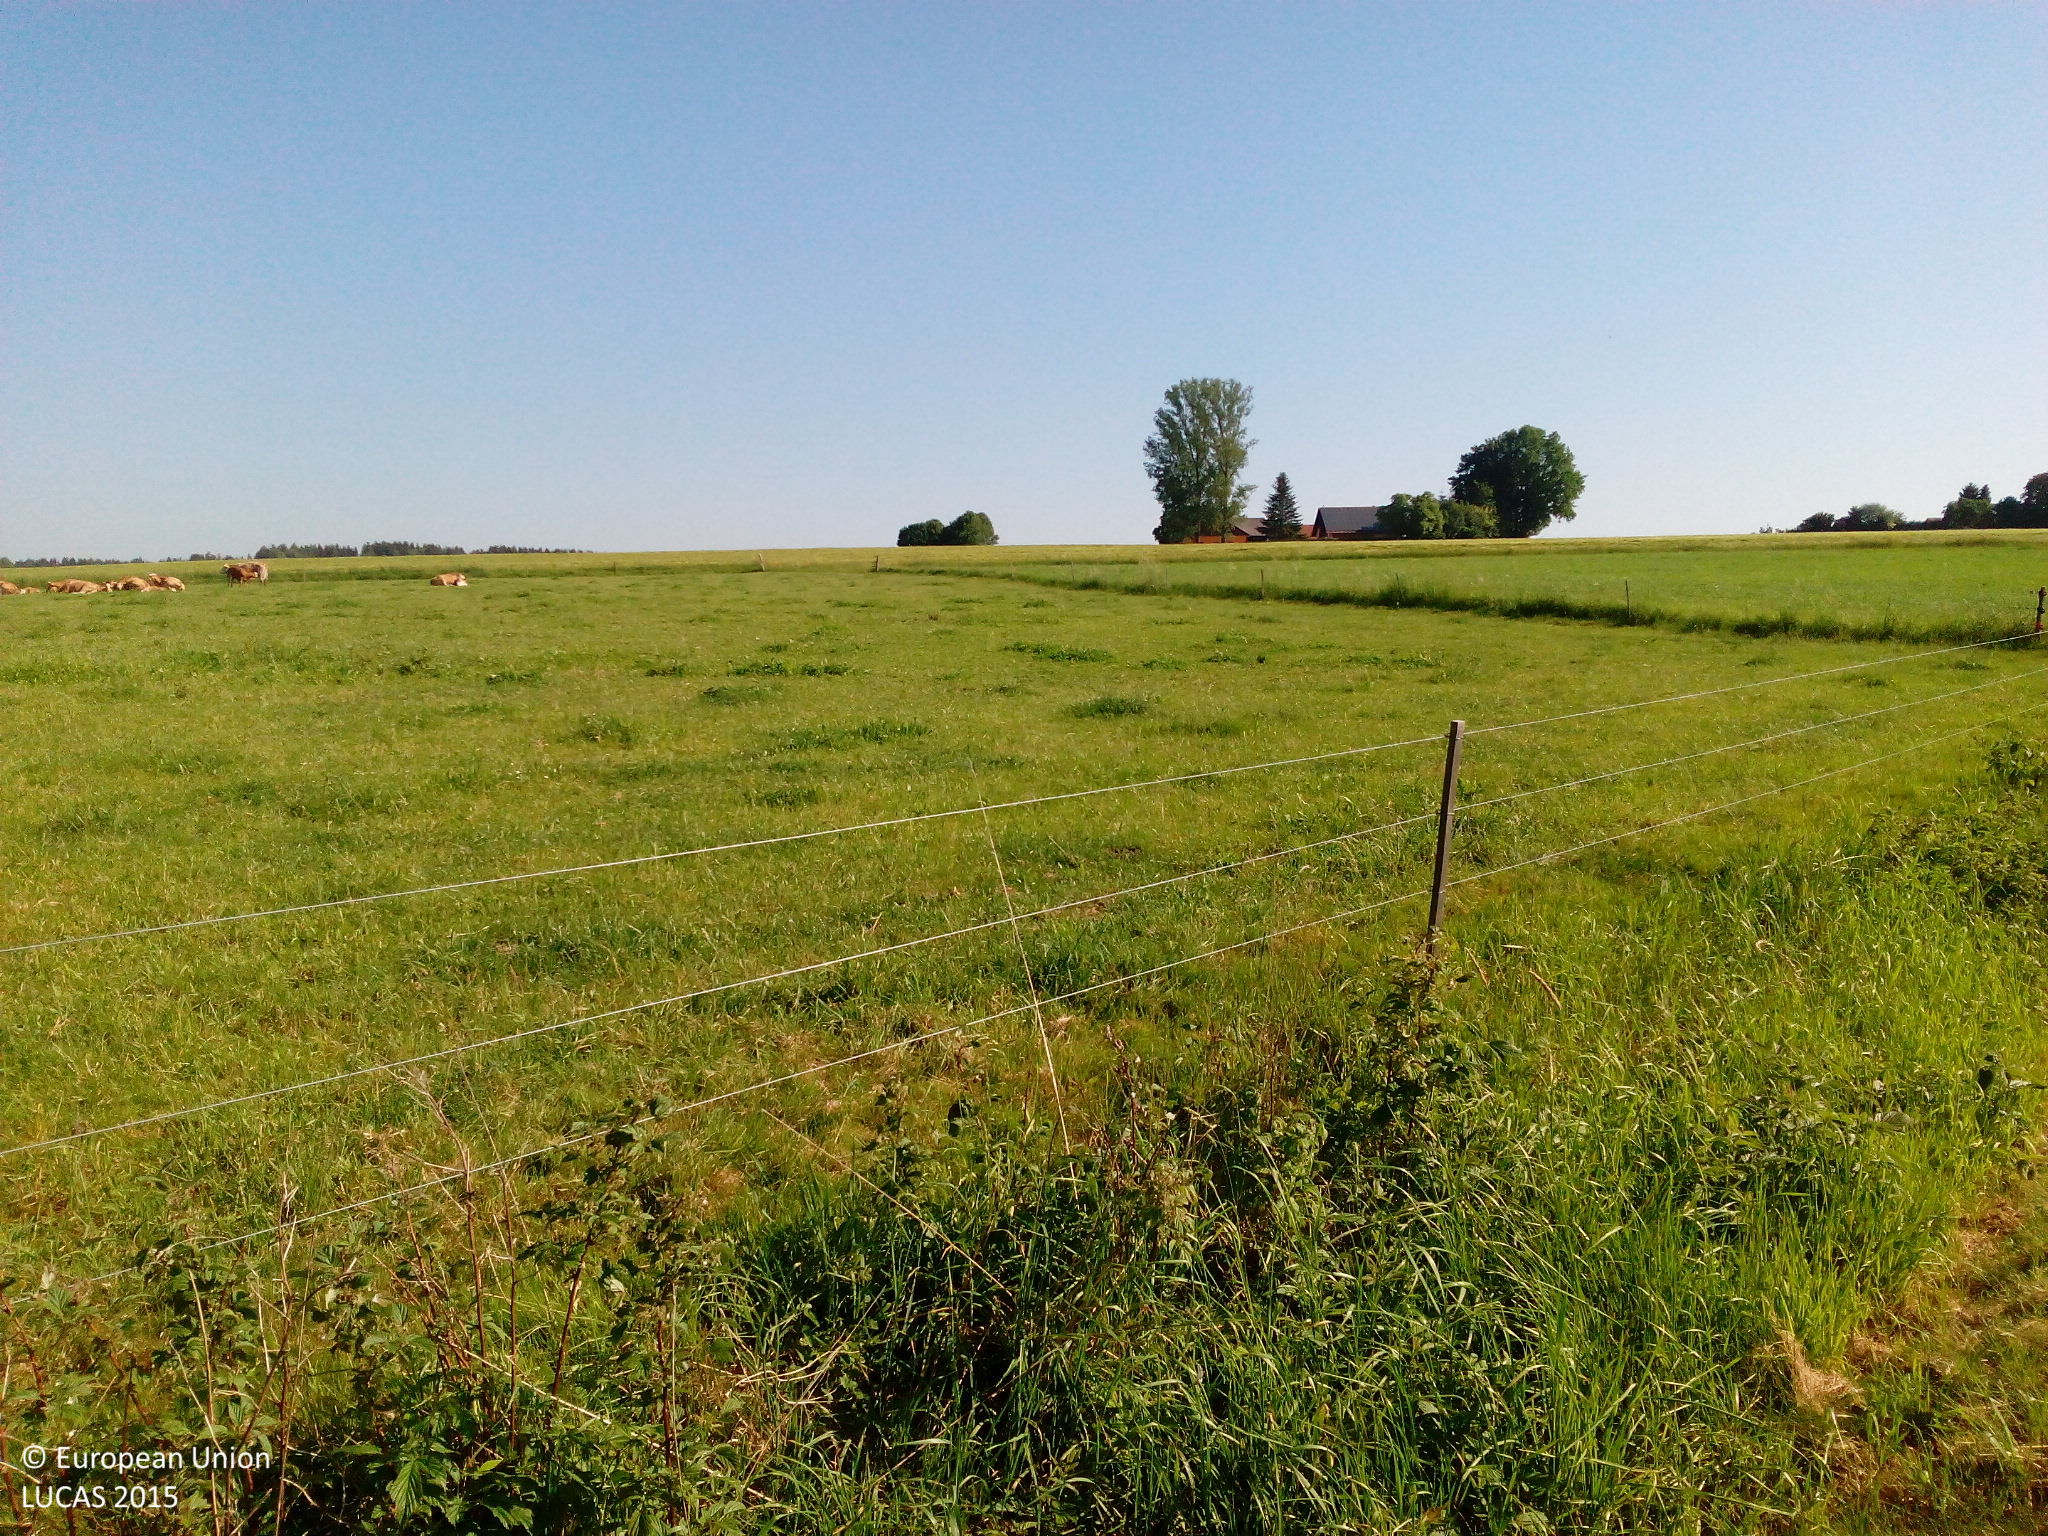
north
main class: Grassland
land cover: Grassland without tree/shrub cover
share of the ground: > 75 %
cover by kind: herbaceous plants 100 %
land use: Agriculture (excluding fallow land and kitchen gardens)
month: June
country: DE
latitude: 49.3306
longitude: 12.4351
